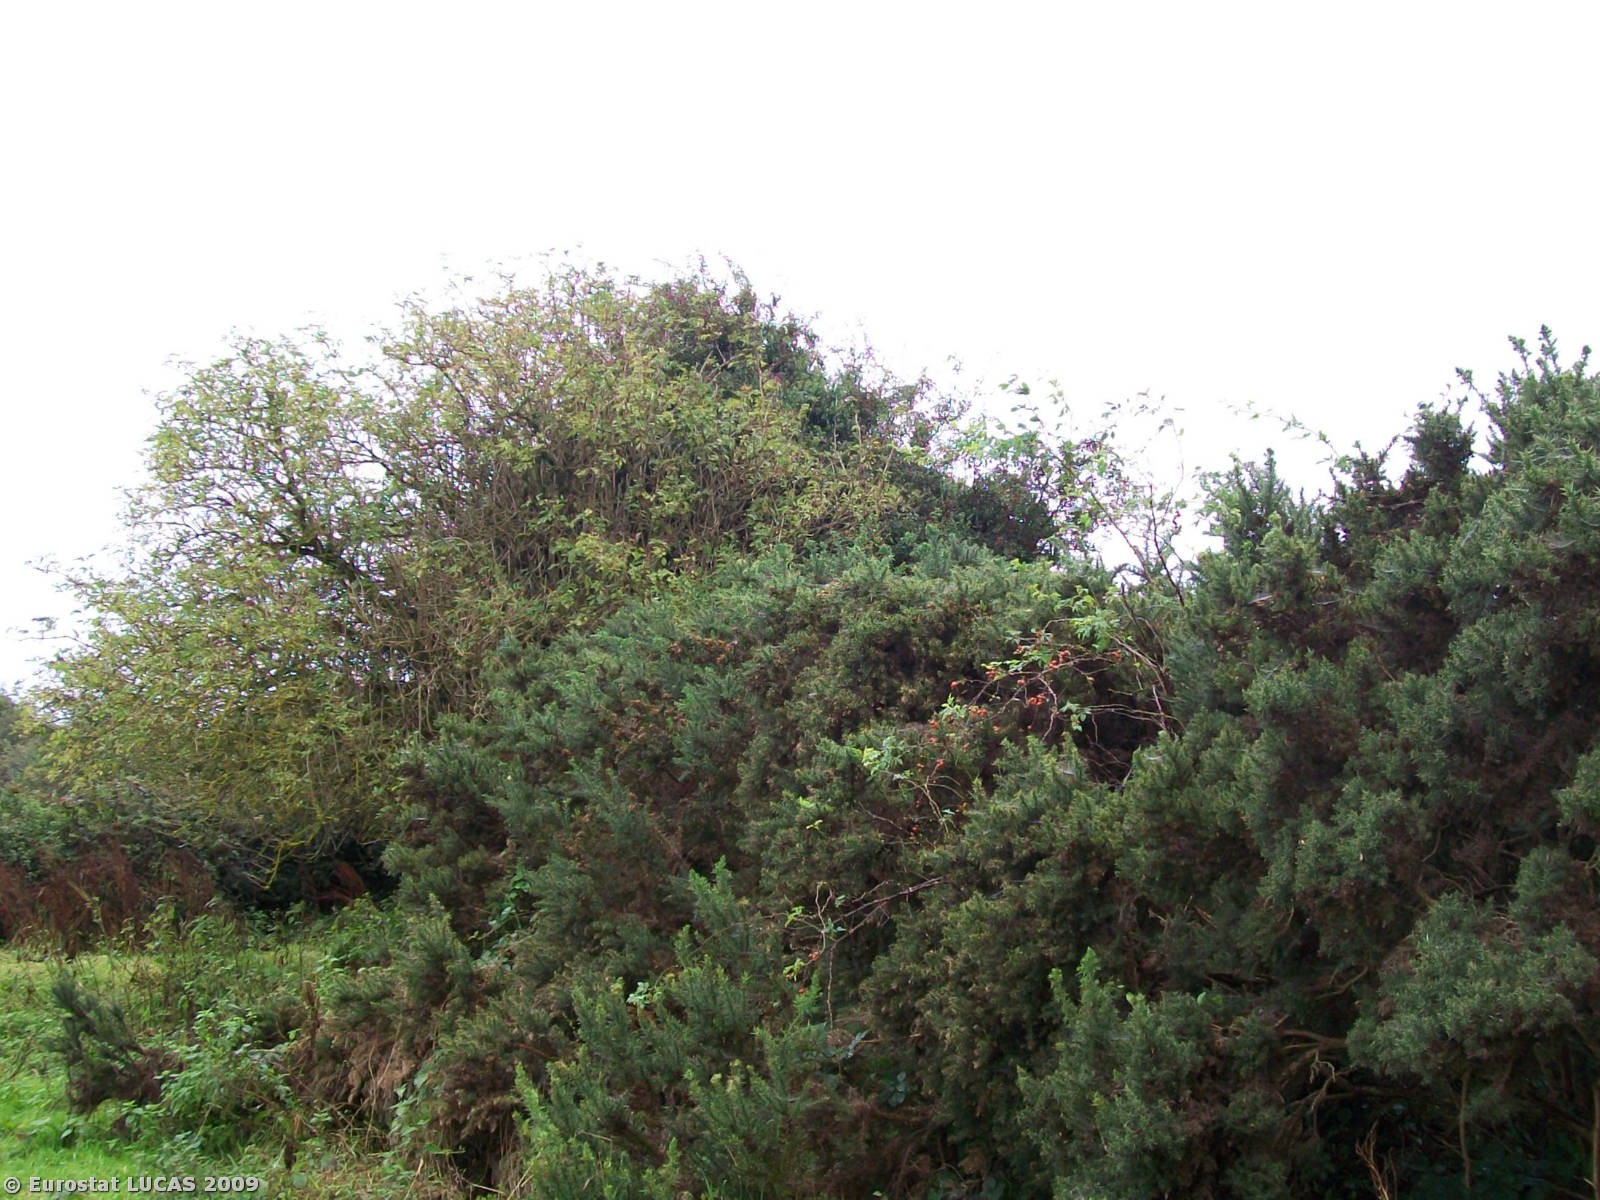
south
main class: Shrubland
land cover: Shrubland without tree cover
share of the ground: > 75 %
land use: Fallow land
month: September
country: IE
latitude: 53.1942
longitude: -7.9093
